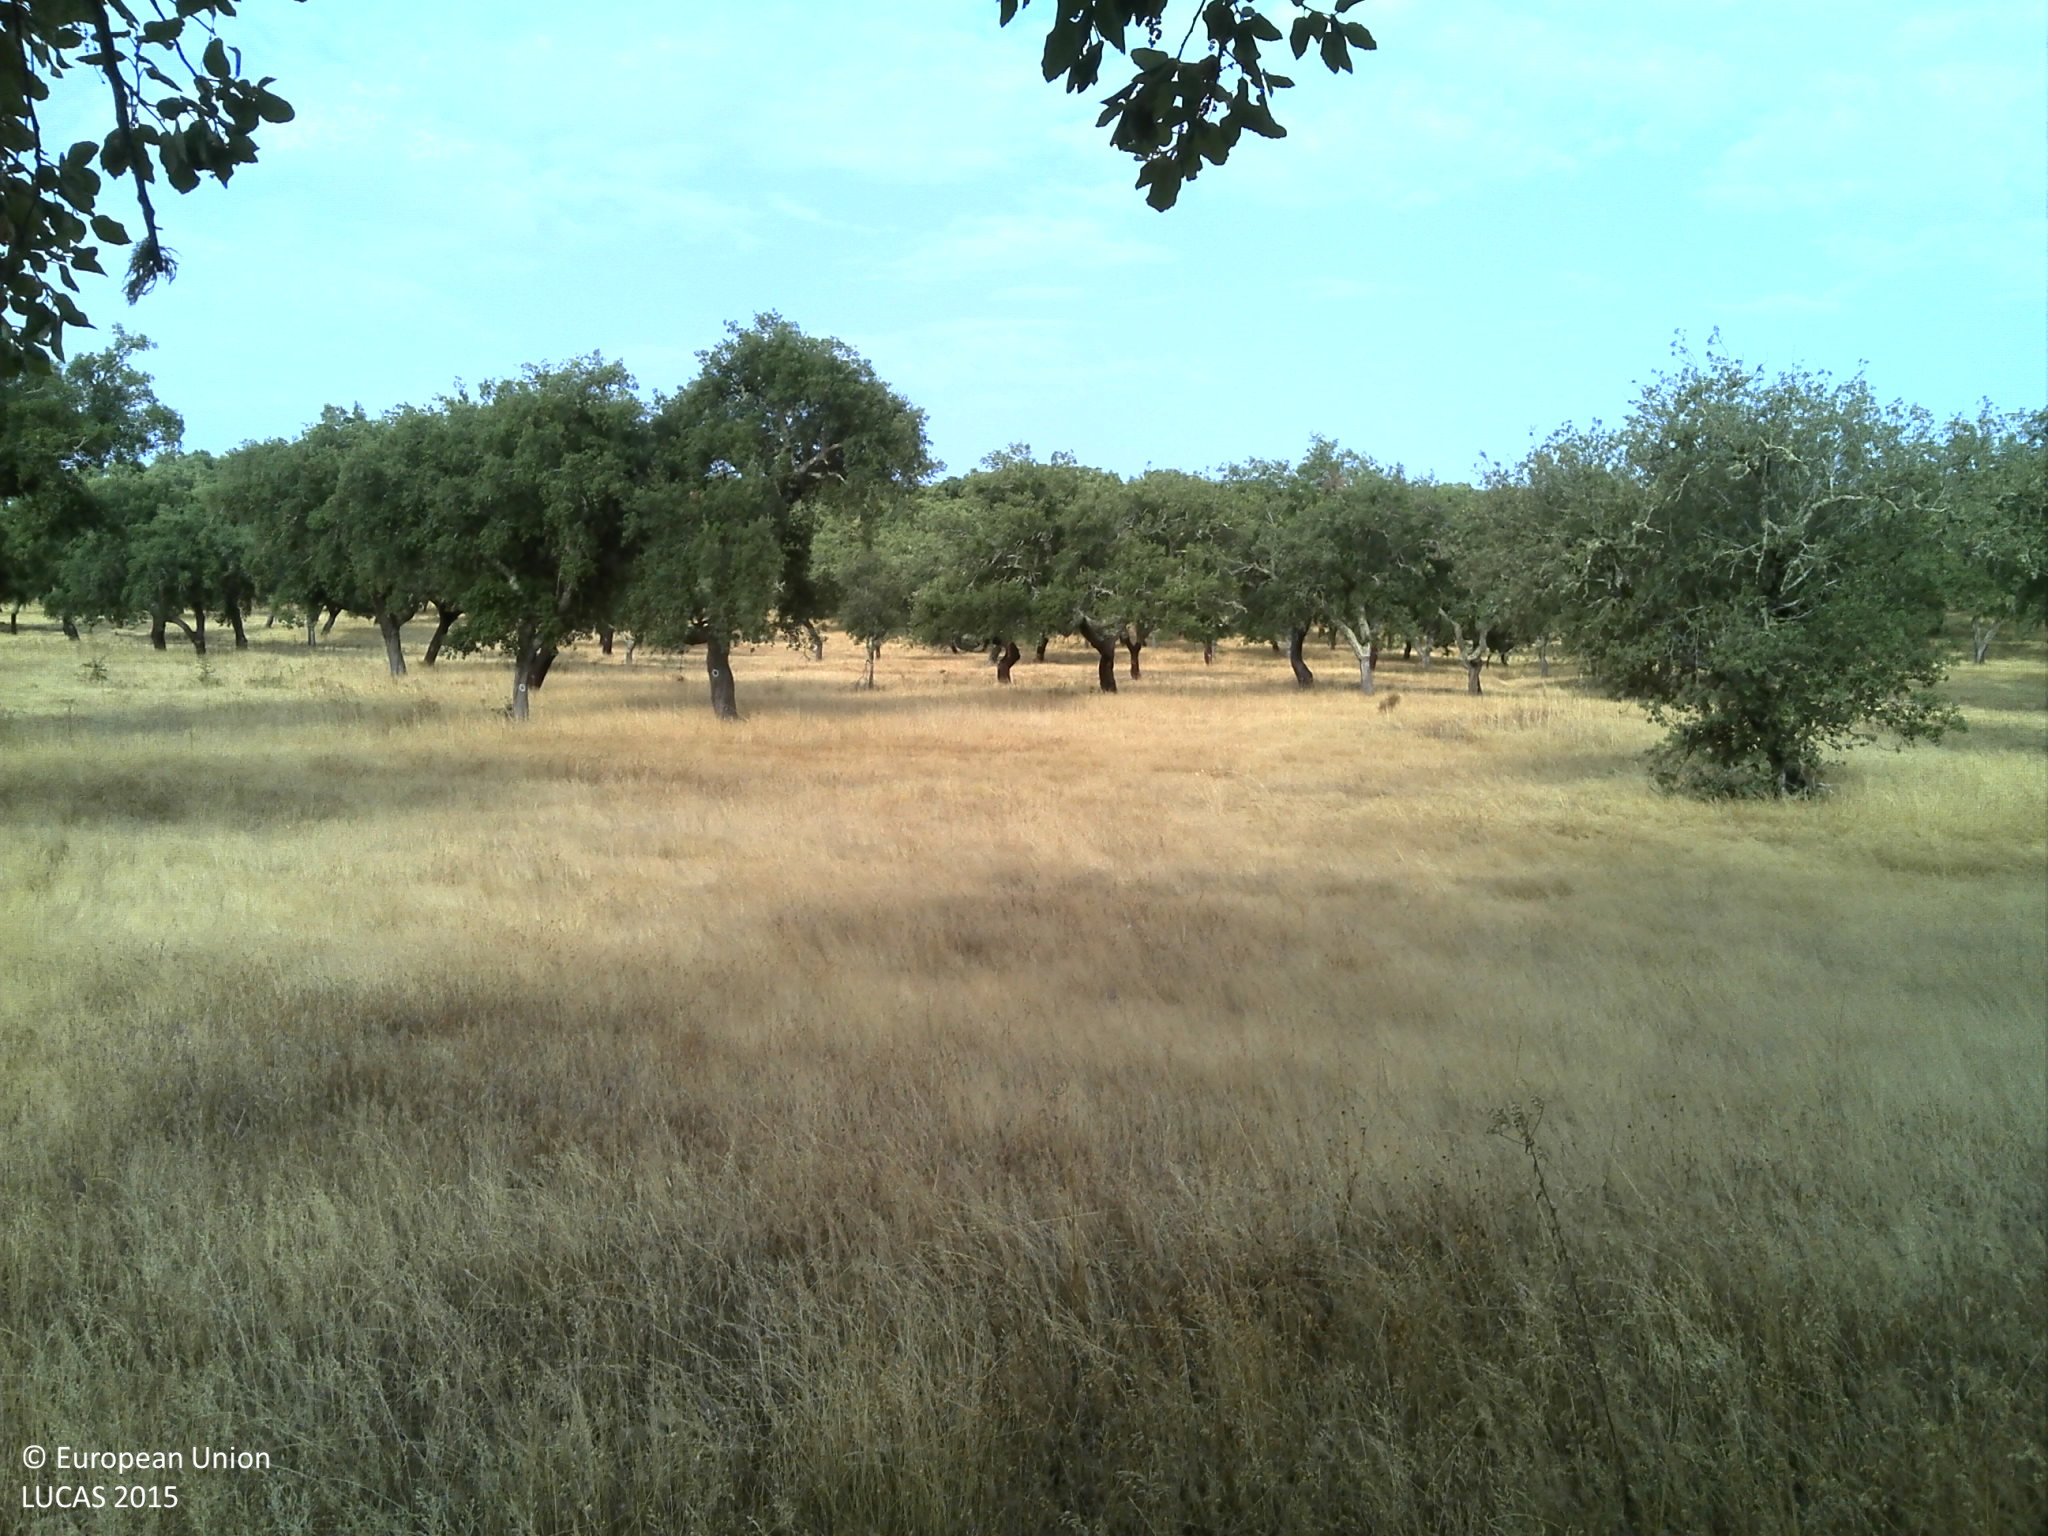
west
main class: Woodland
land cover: Broadleaved woodland
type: broadleaved evergreen forest
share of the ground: 25 - 50 %
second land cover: Grassland without tree/shrub cover
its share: 25 - 50 %
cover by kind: herbaceous plants 50 %, broadleaved forest trees 30 %, unconsolidated bare surface 20 %
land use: Forestry
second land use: Agriculture (excluding fallow land and kitchen gardens)
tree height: > 5 m
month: July
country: PT
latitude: 38.7281
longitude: -7.7412
